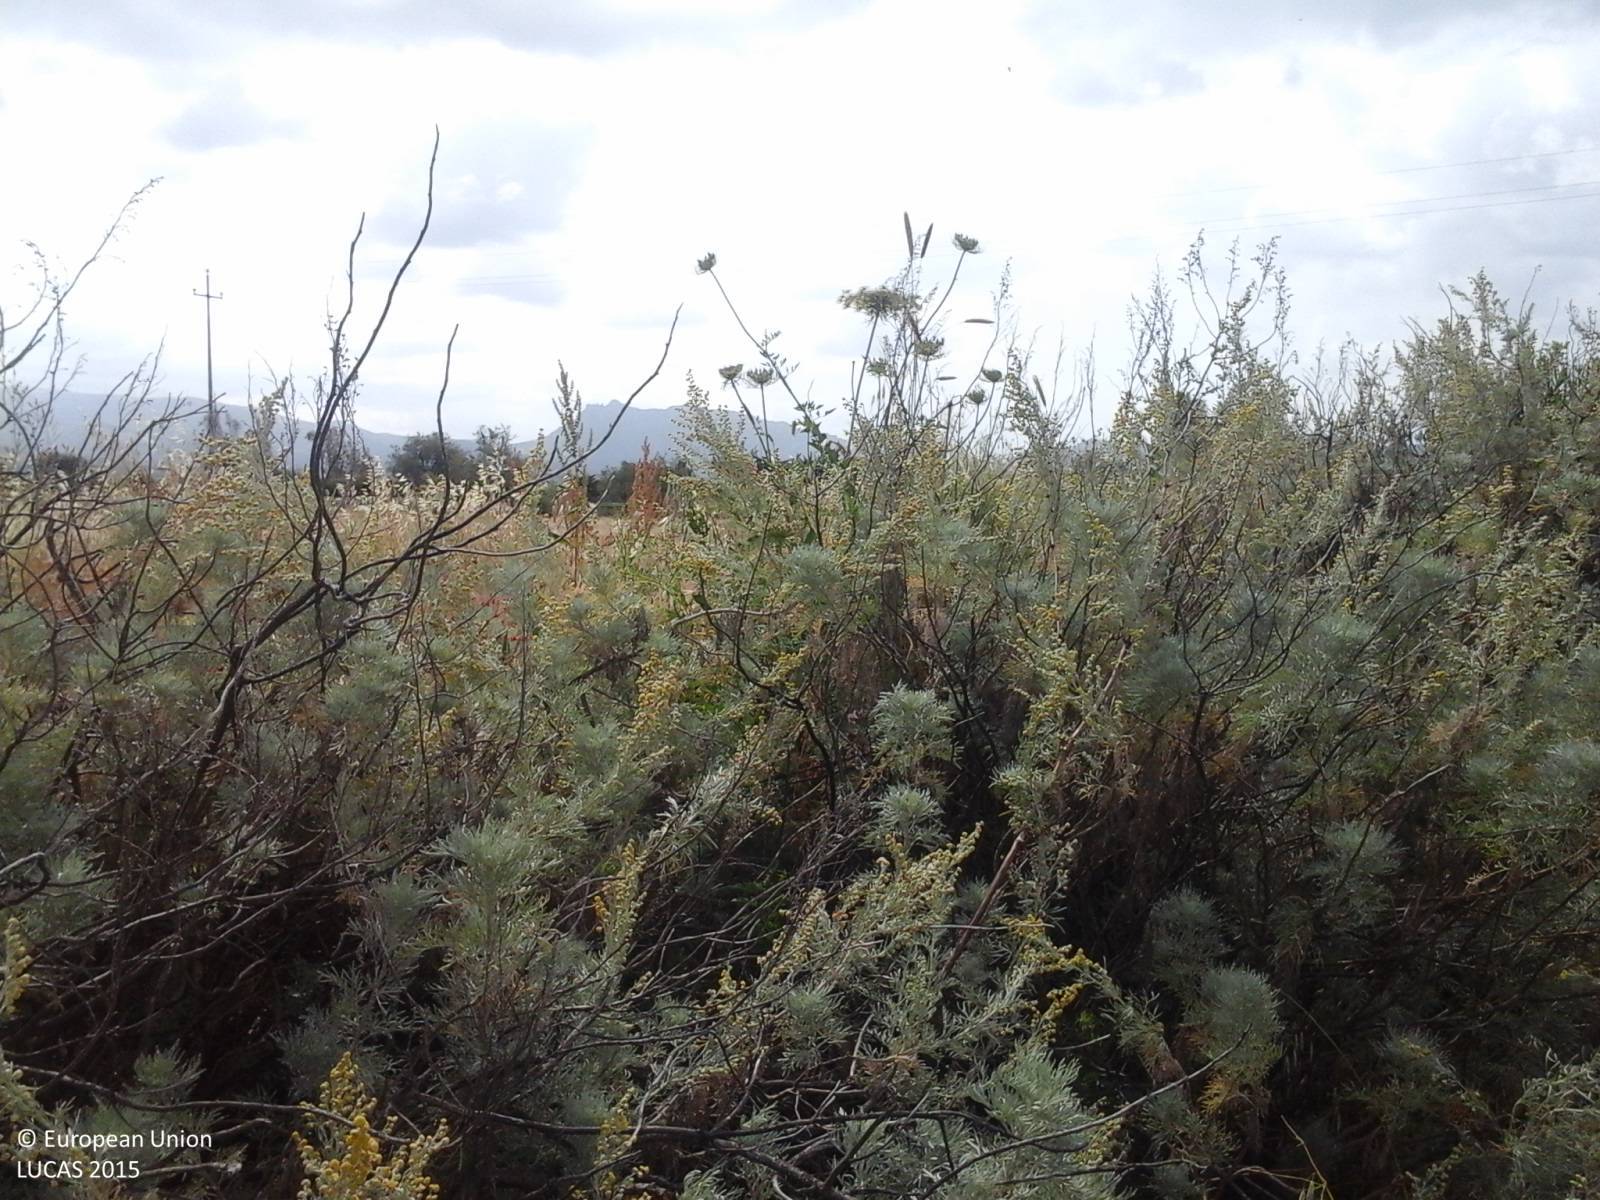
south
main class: Grassland
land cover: Spontaneously vegetated surfaces
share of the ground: > 75 %
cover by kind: herbaceous plants 100 %
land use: Agriculture (excluding fallow land and kitchen gardens)
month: May
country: IT
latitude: 40.9483
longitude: 8.8531
